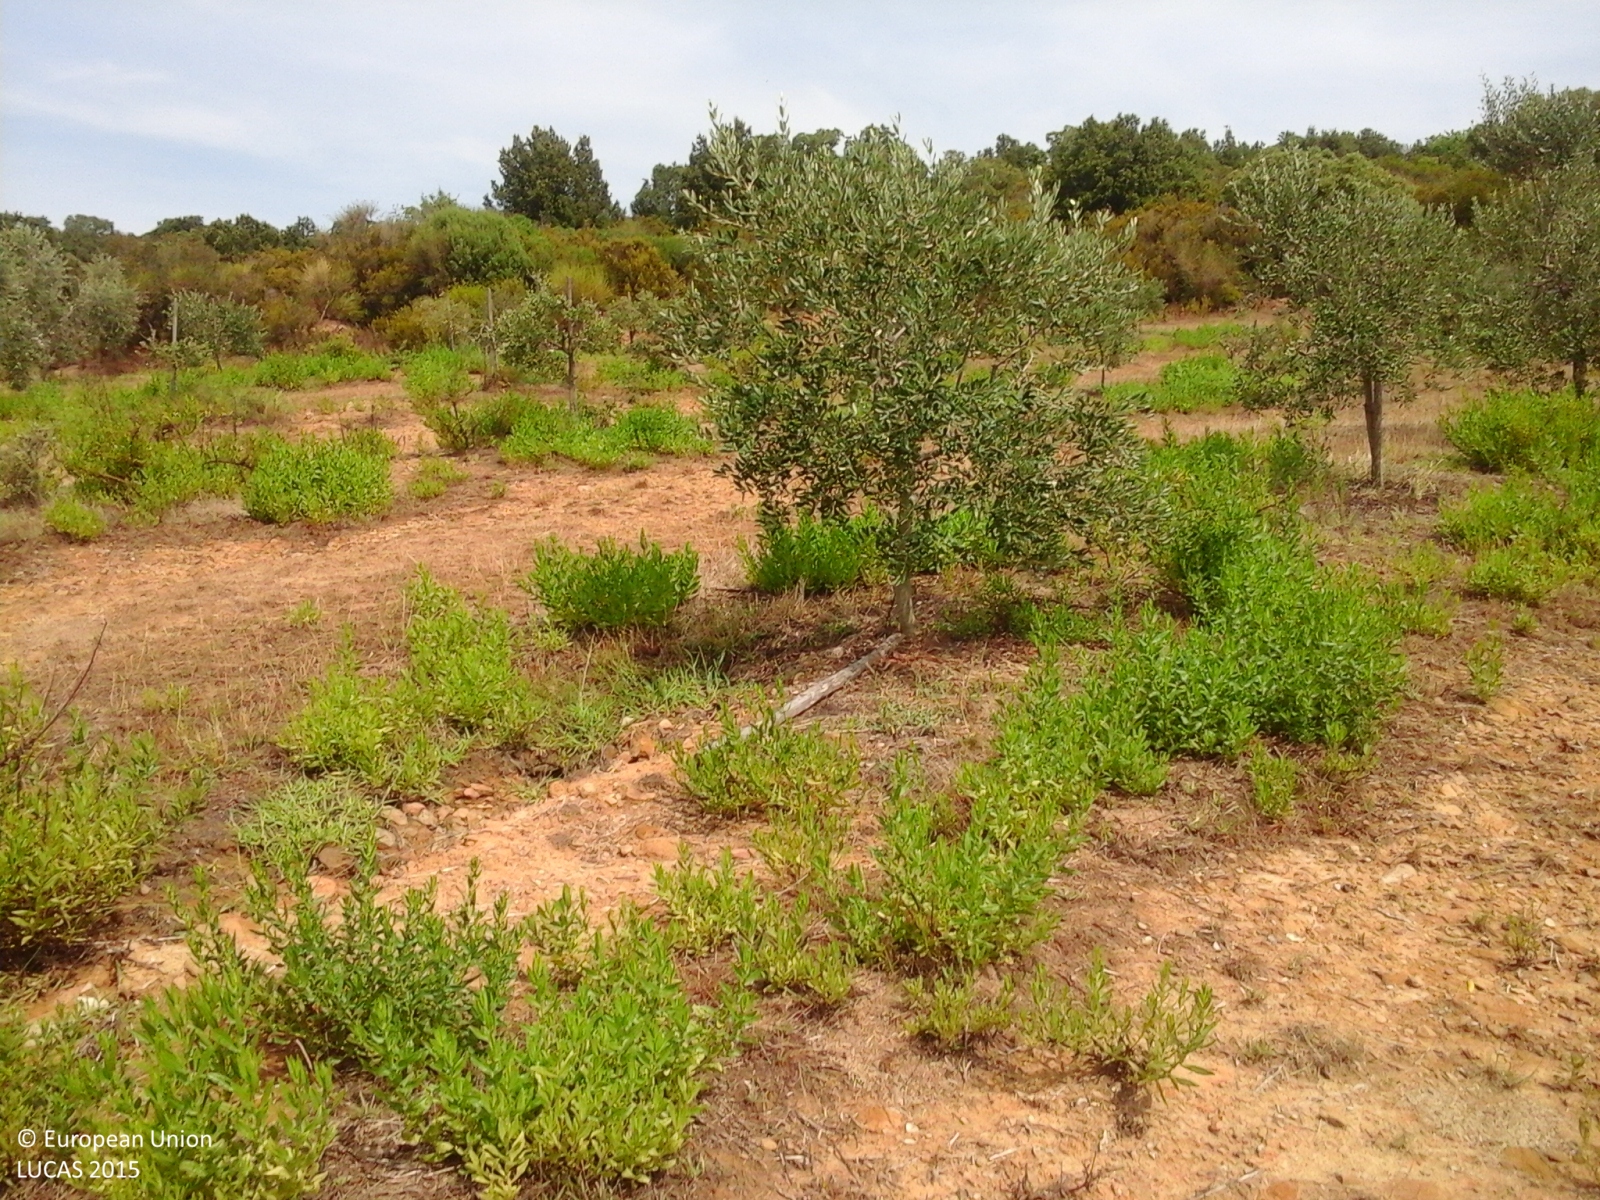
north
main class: Cropland
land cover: Olive groves
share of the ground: 50 - 75 %
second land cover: Spontaneously vegetated surfaces
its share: 25 - 50 %
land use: Agriculture (excluding fallow land and kitchen gardens)
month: August
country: IT
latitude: 42.8844
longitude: 10.9398
